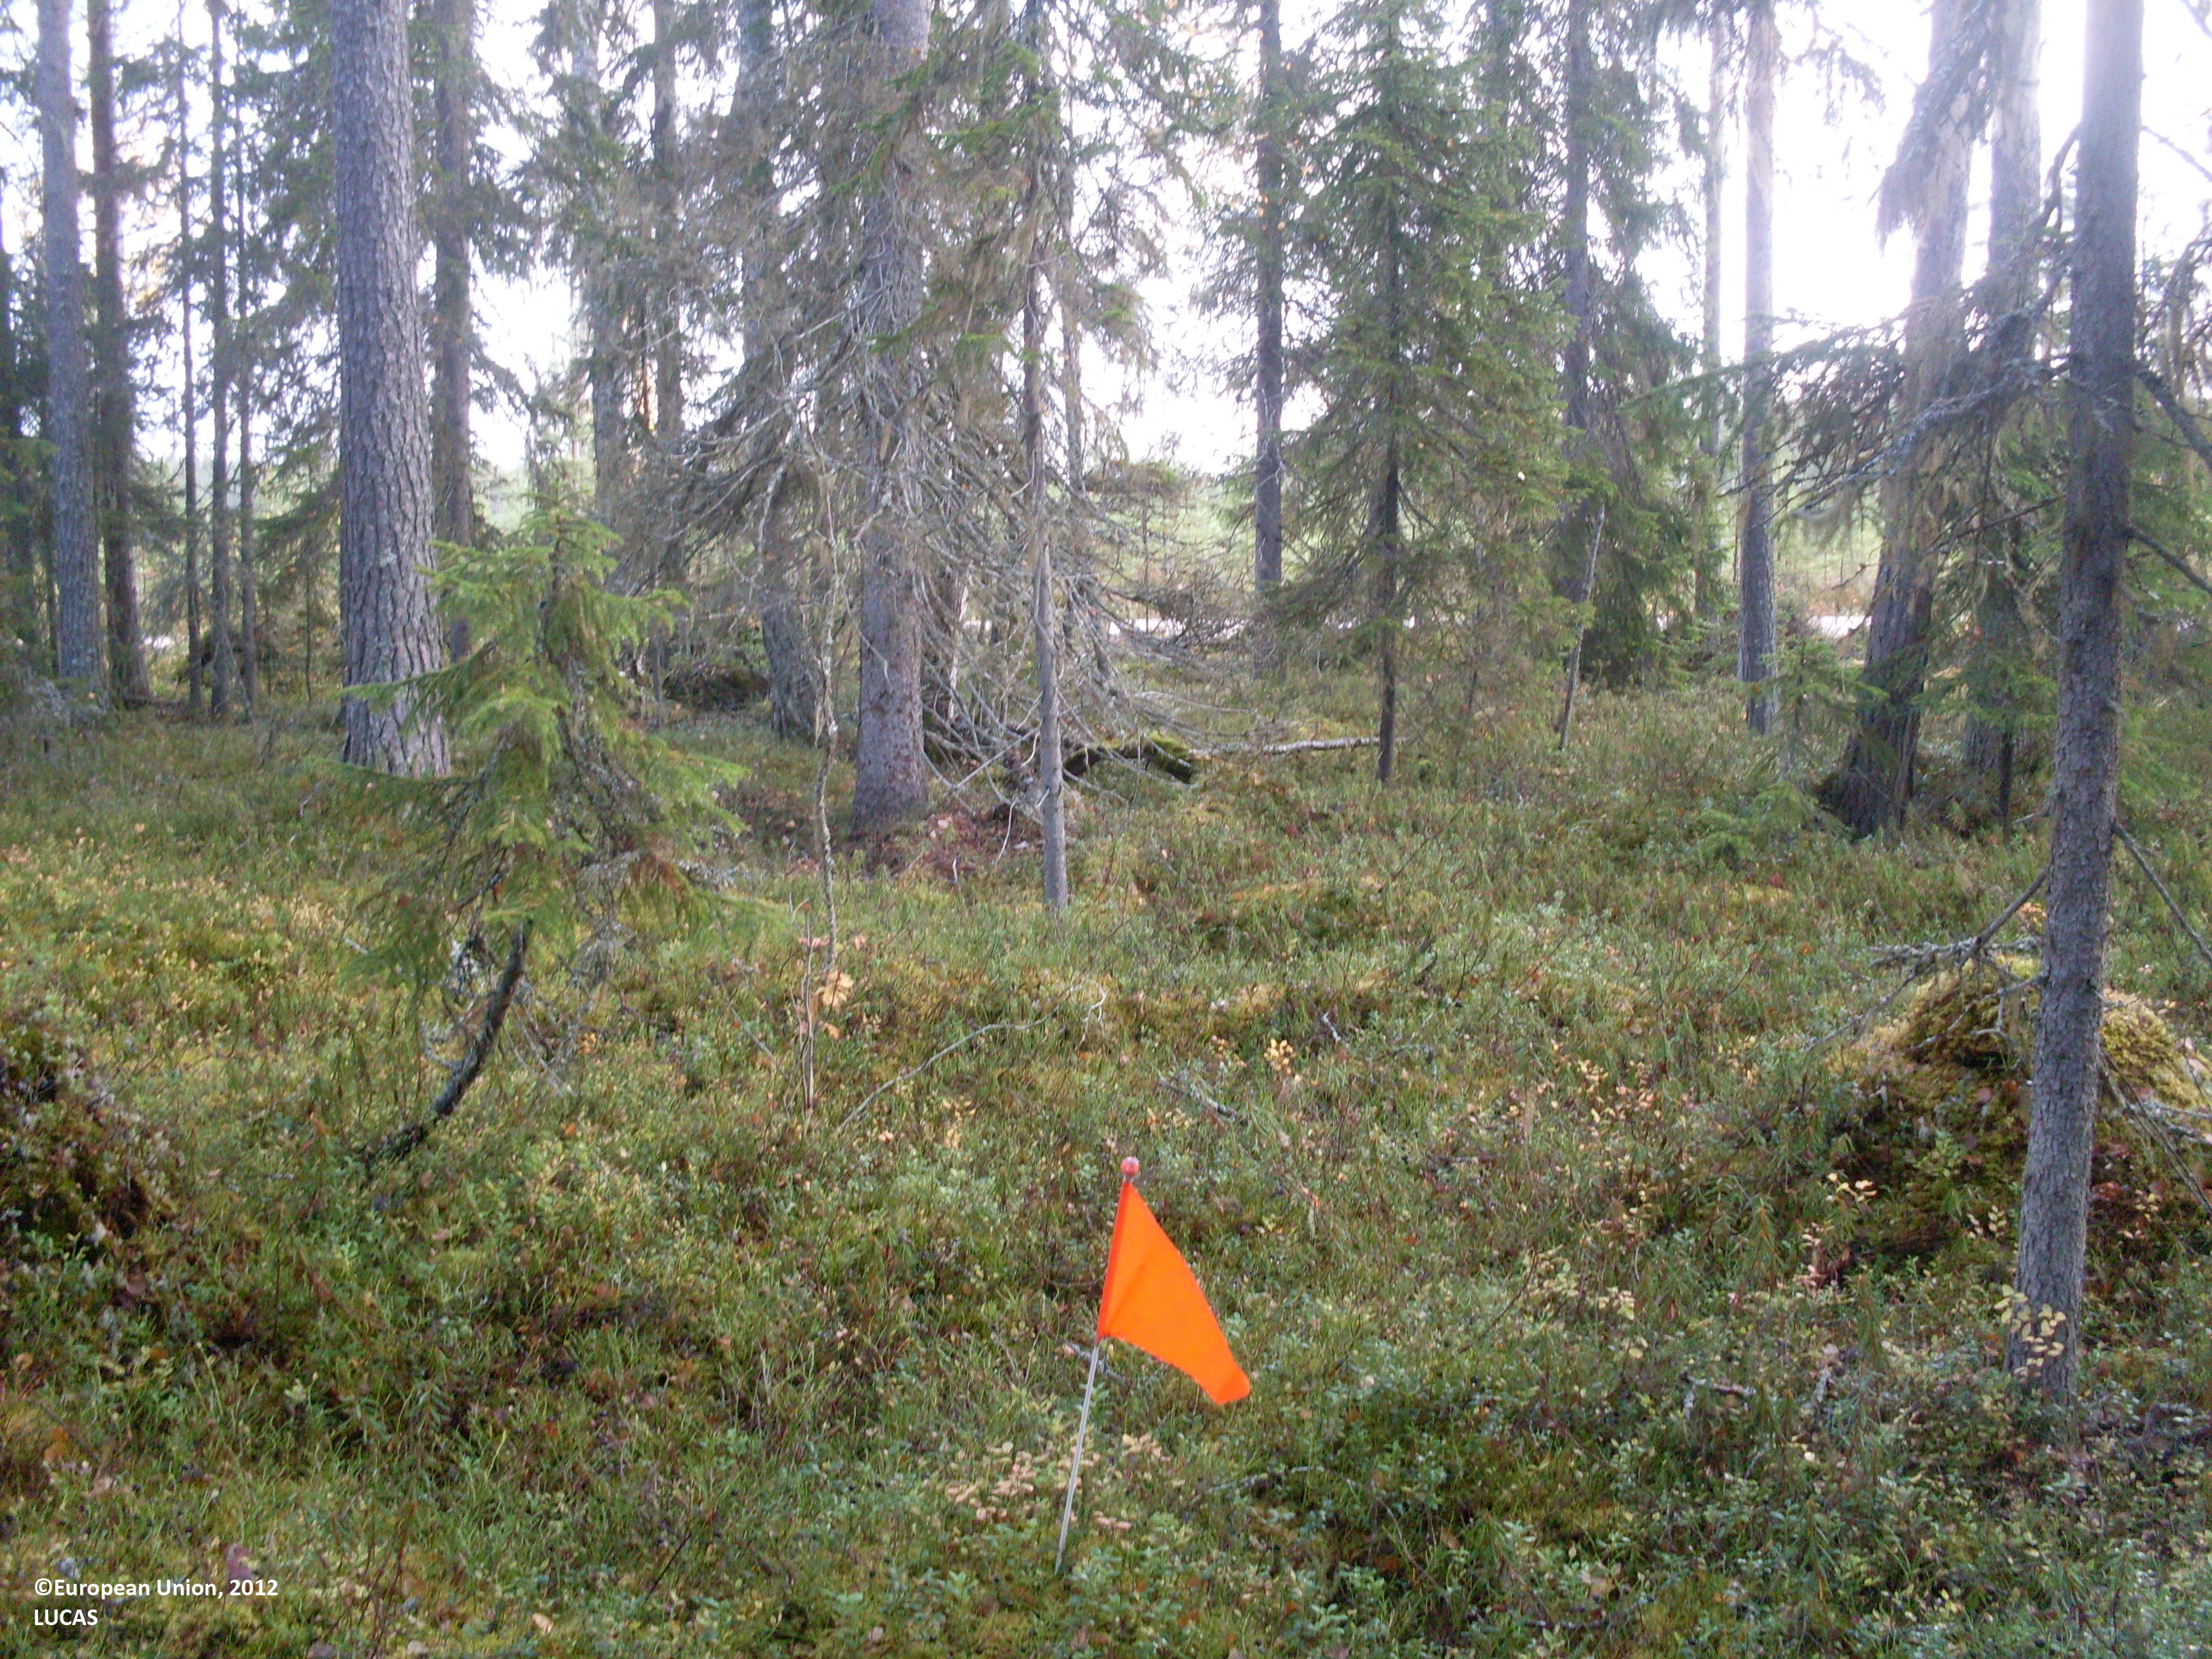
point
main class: Woodland
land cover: Pine dominated mixed woodland
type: boreal forest
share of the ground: 50 - 75 %
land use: Forestry
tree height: > 5 m
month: September
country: FI
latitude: 64.7094
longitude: 29.3151
